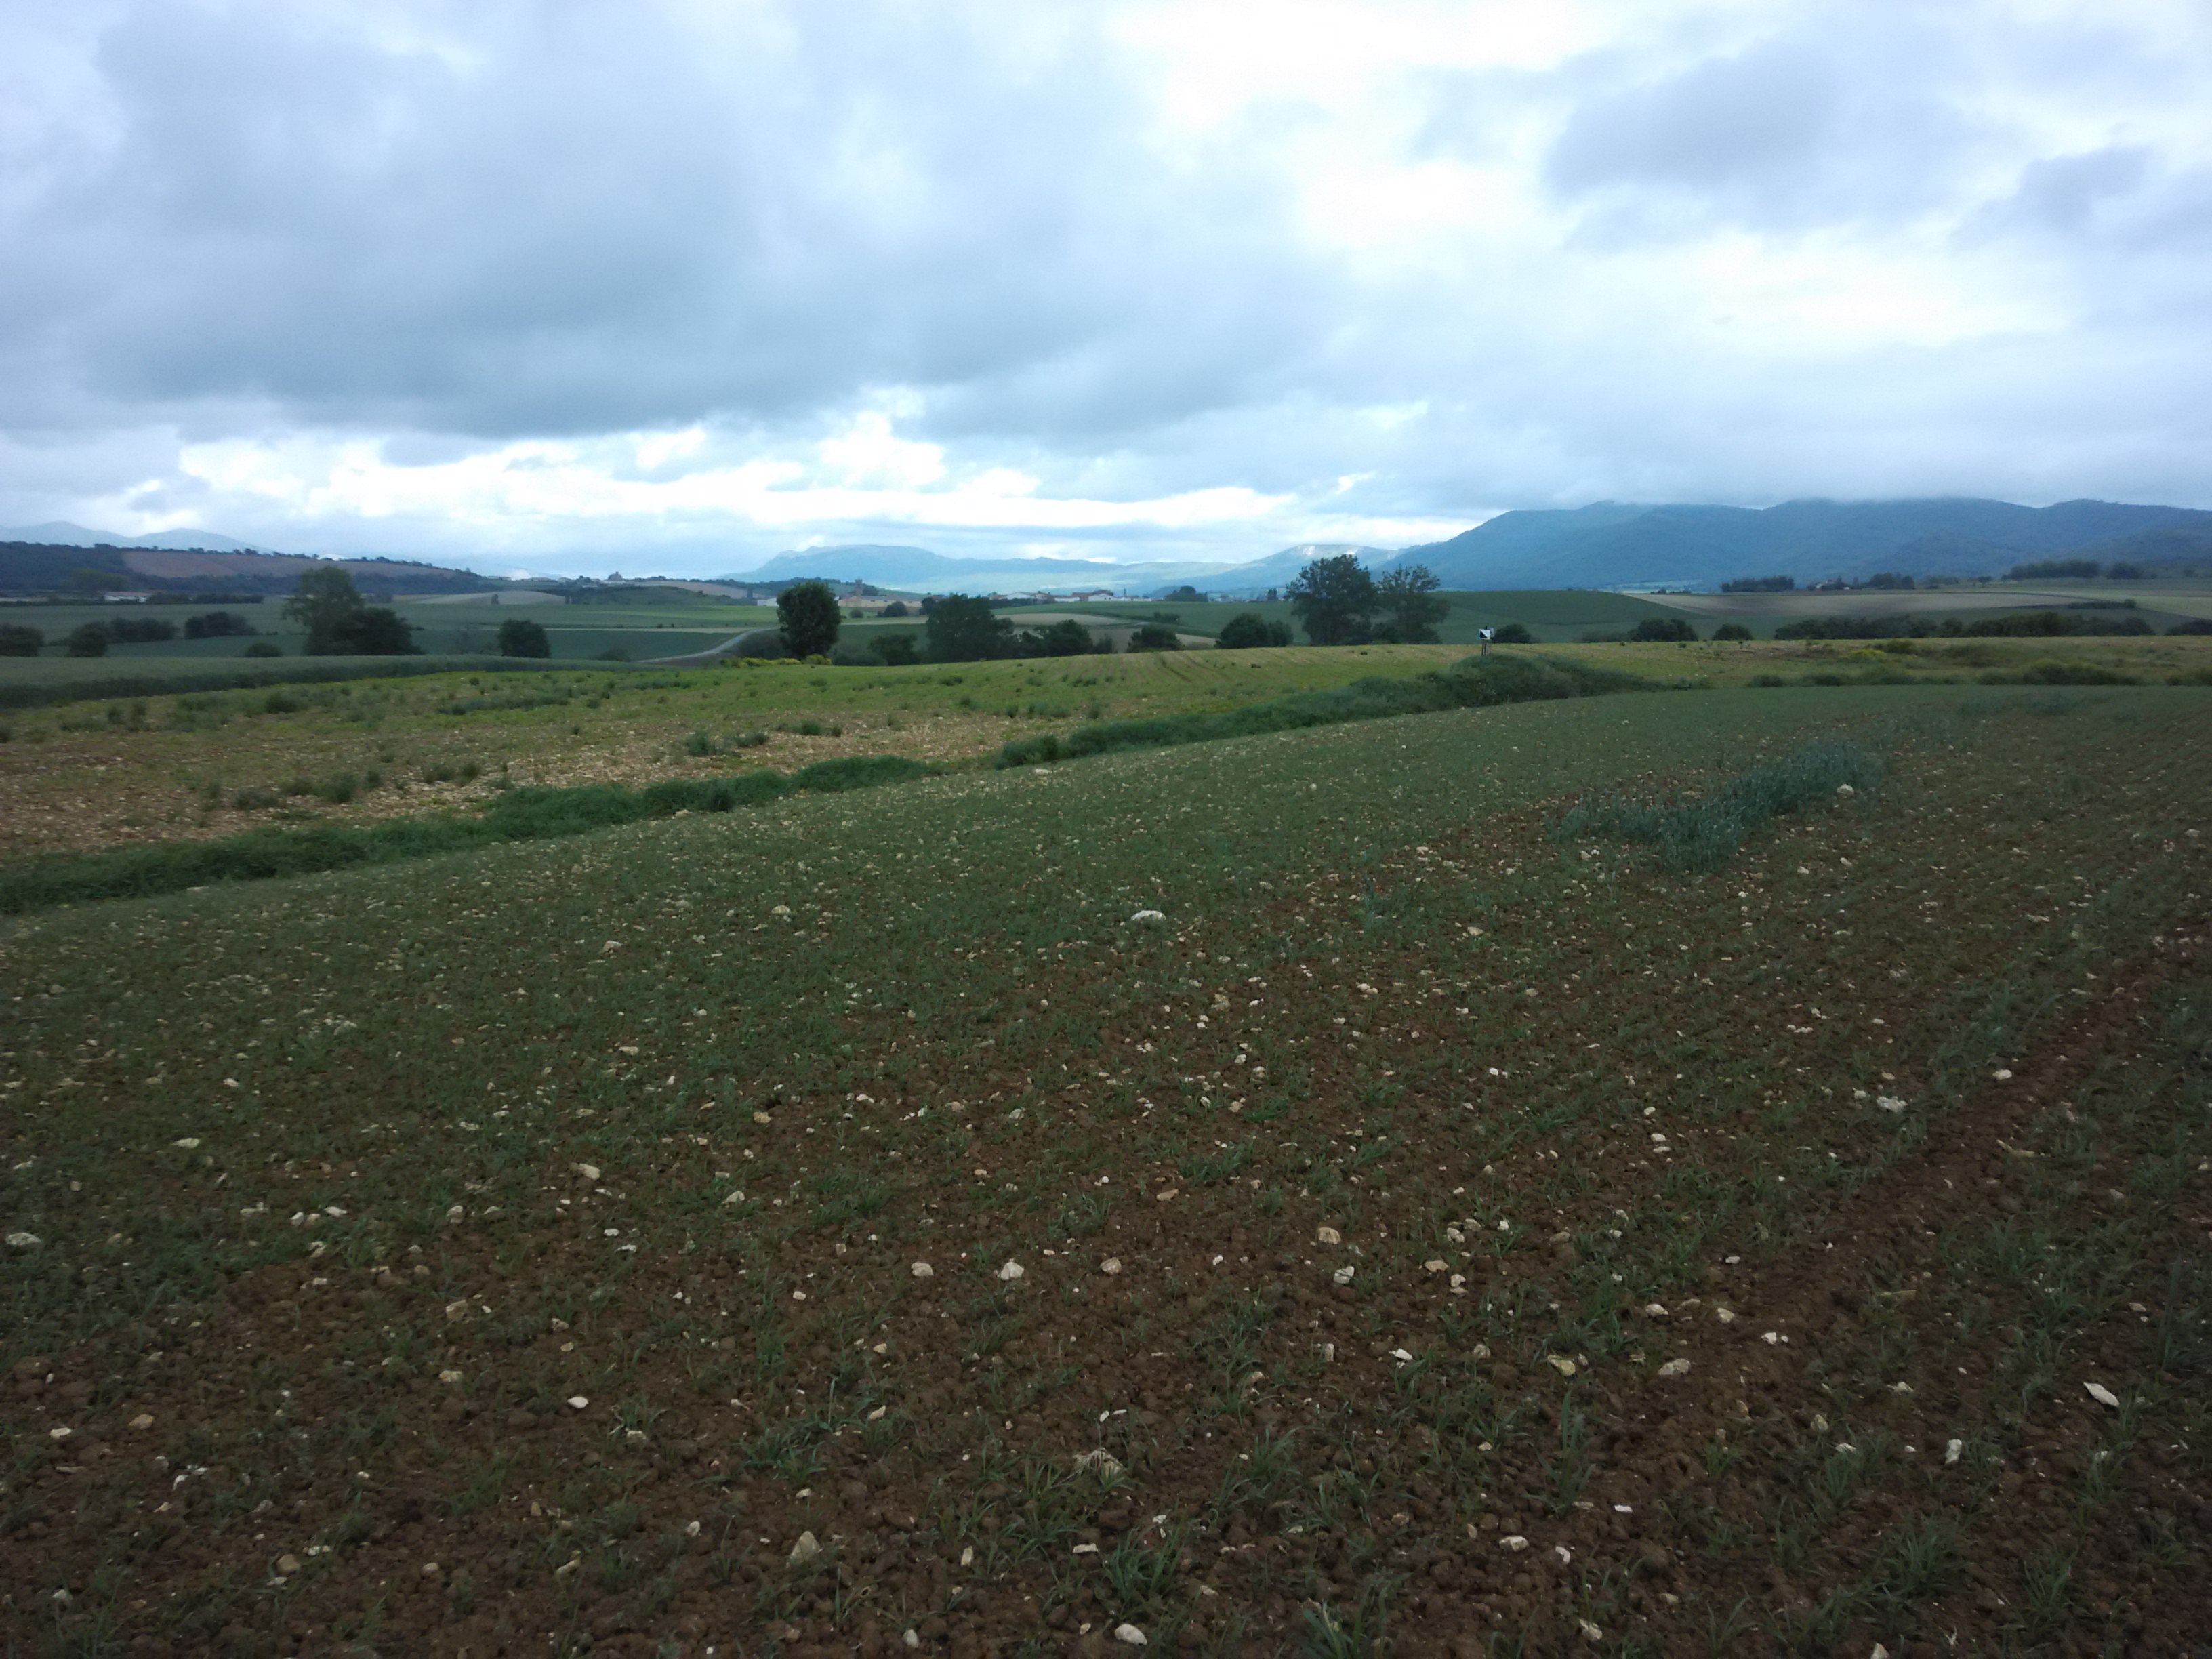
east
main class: Cropland
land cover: Mixed cereals for fodder
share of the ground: 10 - 25 %
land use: Agriculture (excluding fallow land and kitchen gardens)
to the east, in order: Mixed cereals for fodder; Grass margins; Sugar beet
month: May
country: ES
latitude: 42.8237
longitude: -2.5133
